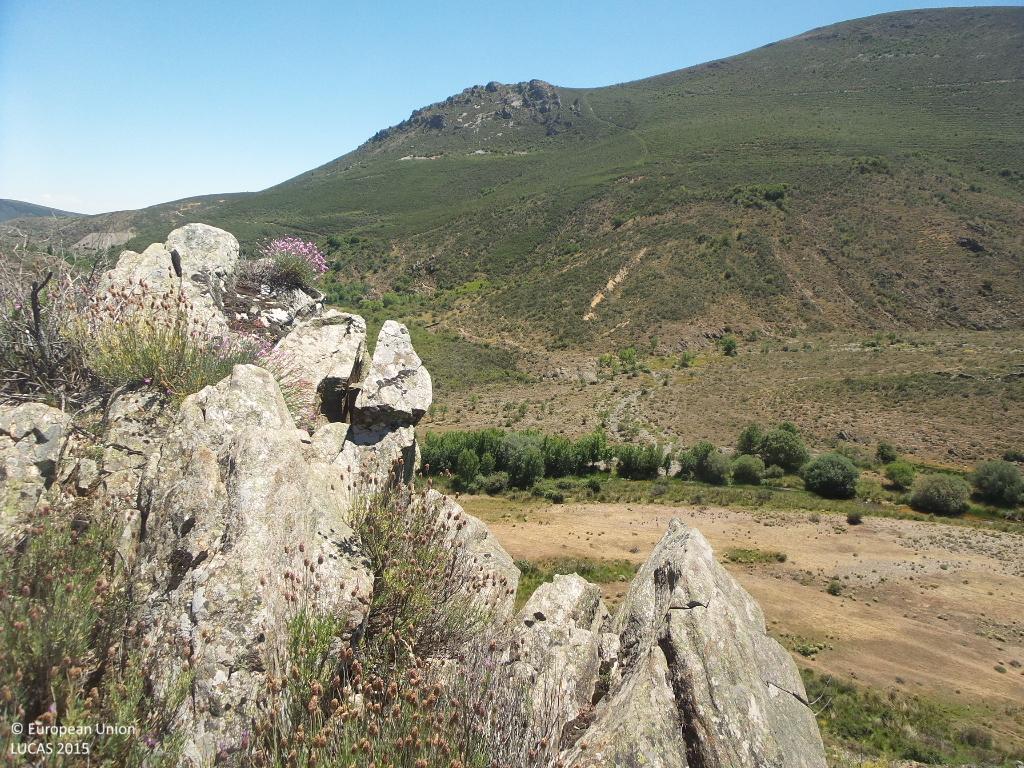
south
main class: Shrubland
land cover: Shrubland without tree cover
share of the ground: 10 - 25 %
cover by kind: consolidated bare surface 50 %, unconsolidated bare surface 30 %, shrubs 20 %
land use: Semi-natural and natural areas not in use
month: June
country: ES
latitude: 41.1293
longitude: -2.9129
